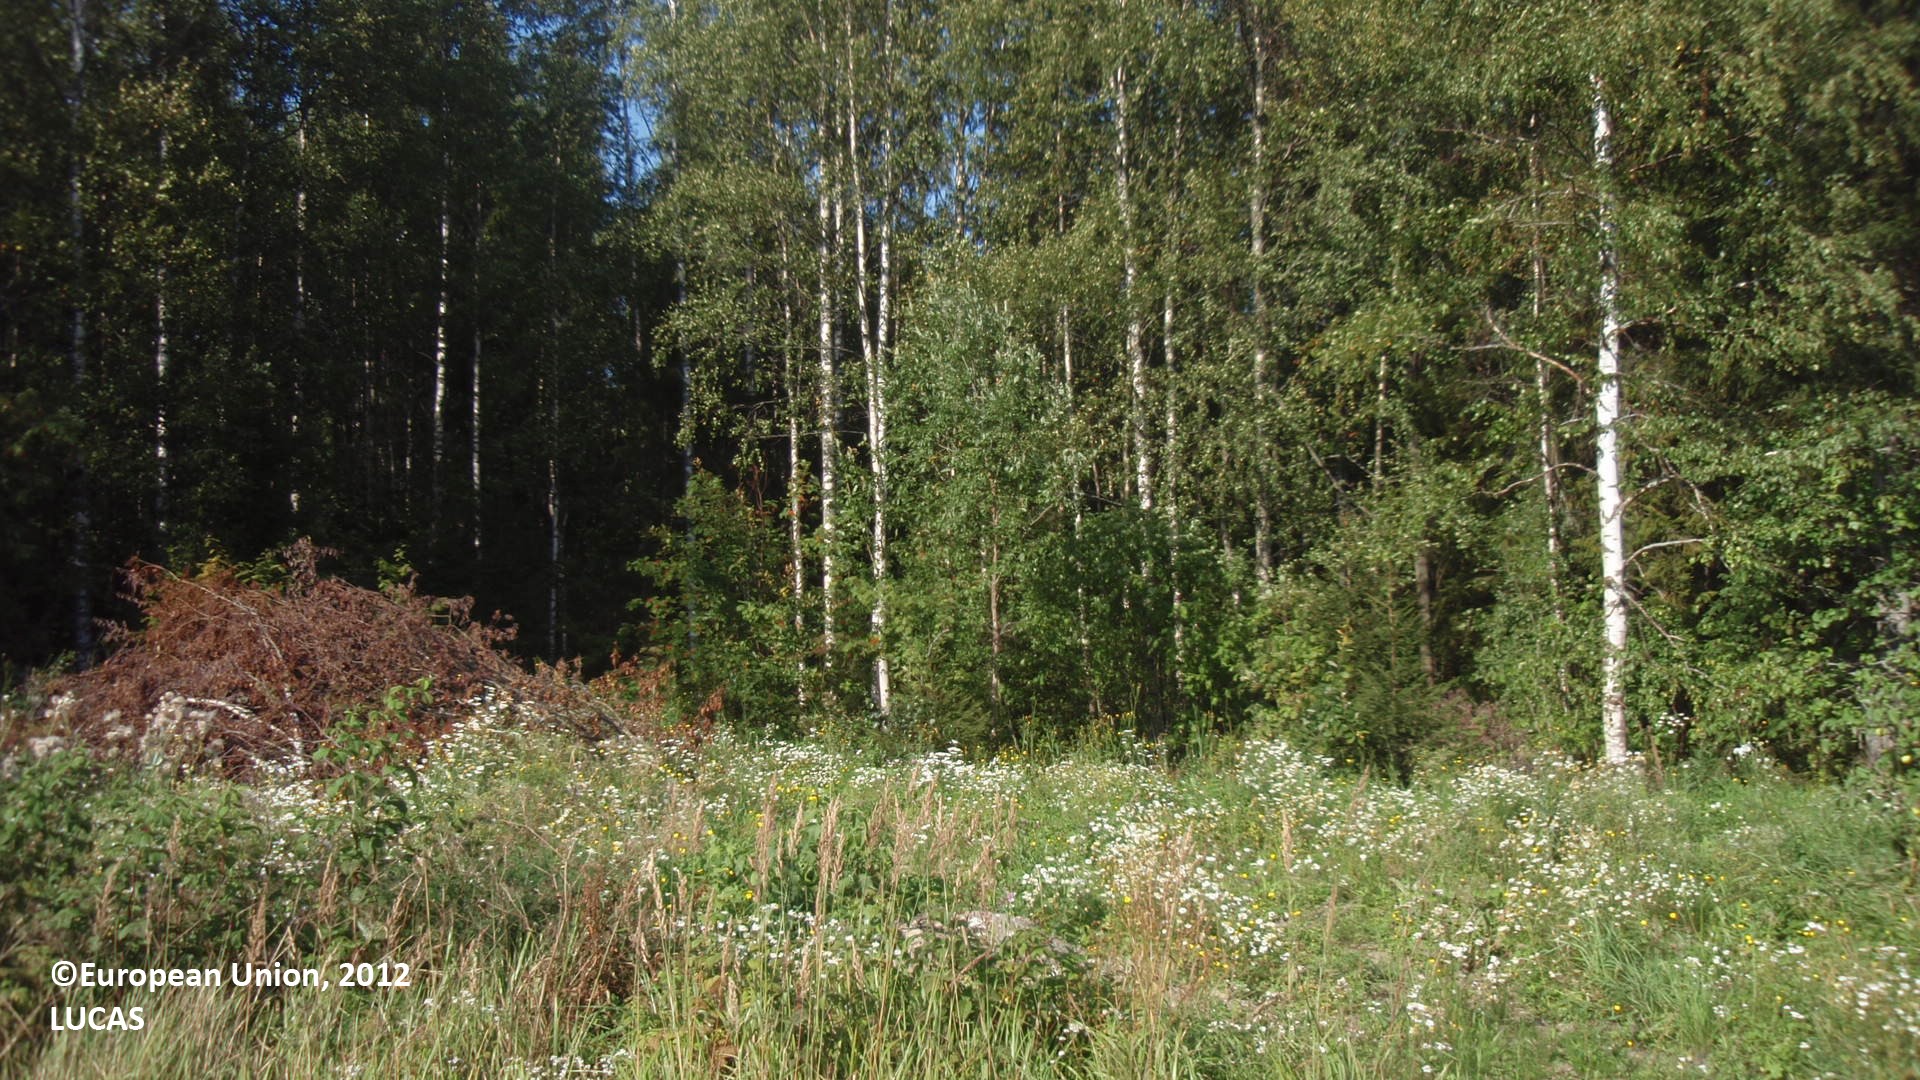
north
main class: Cropland
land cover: Oats
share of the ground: > 75 %
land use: Agriculture (excluding fallow land and kitchen gardens)
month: August
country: FI
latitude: 60.8104
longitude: 26.6080
